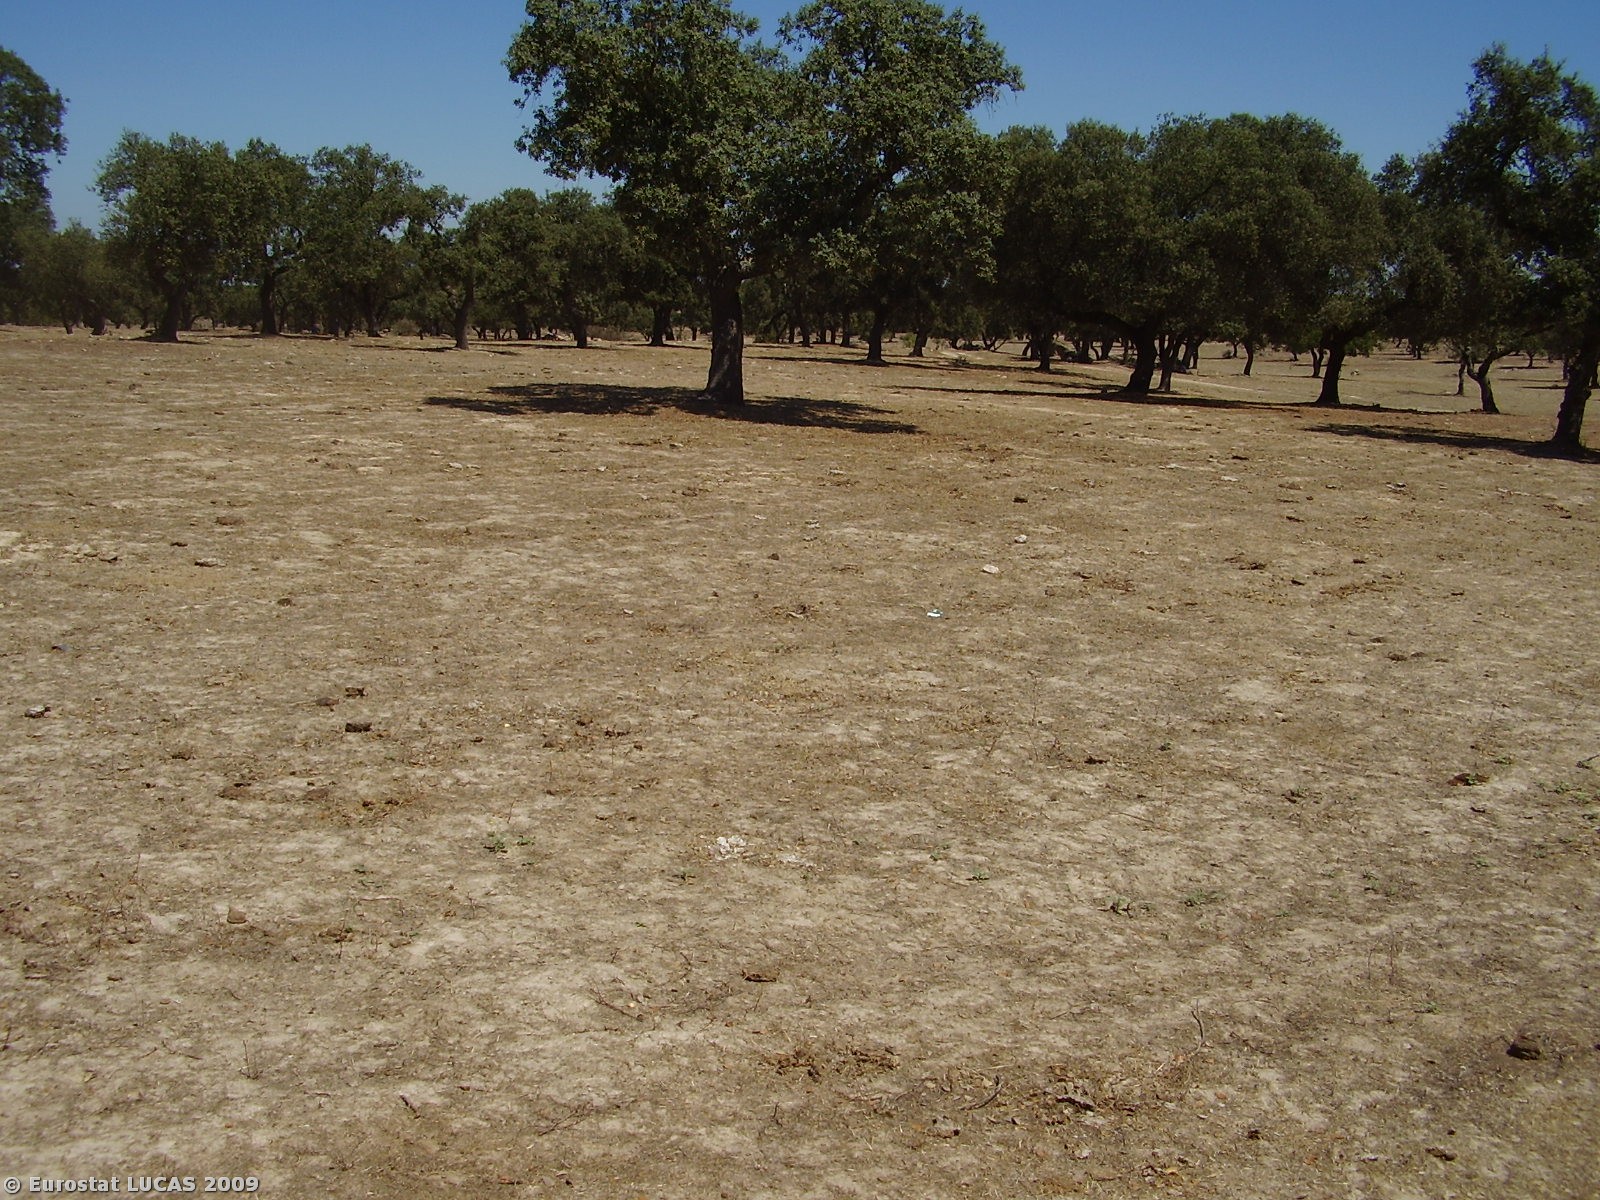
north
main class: Woodland
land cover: Broadleaved woodland
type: broadleaved evergreen forest
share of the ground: 10 - 25 %
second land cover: Grassland with sparse tree/shrub cover
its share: 10 - 25 %
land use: Forestry
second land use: Fallow land
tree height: > 5 m
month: July
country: PT
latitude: 38.8610
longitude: -7.9193
